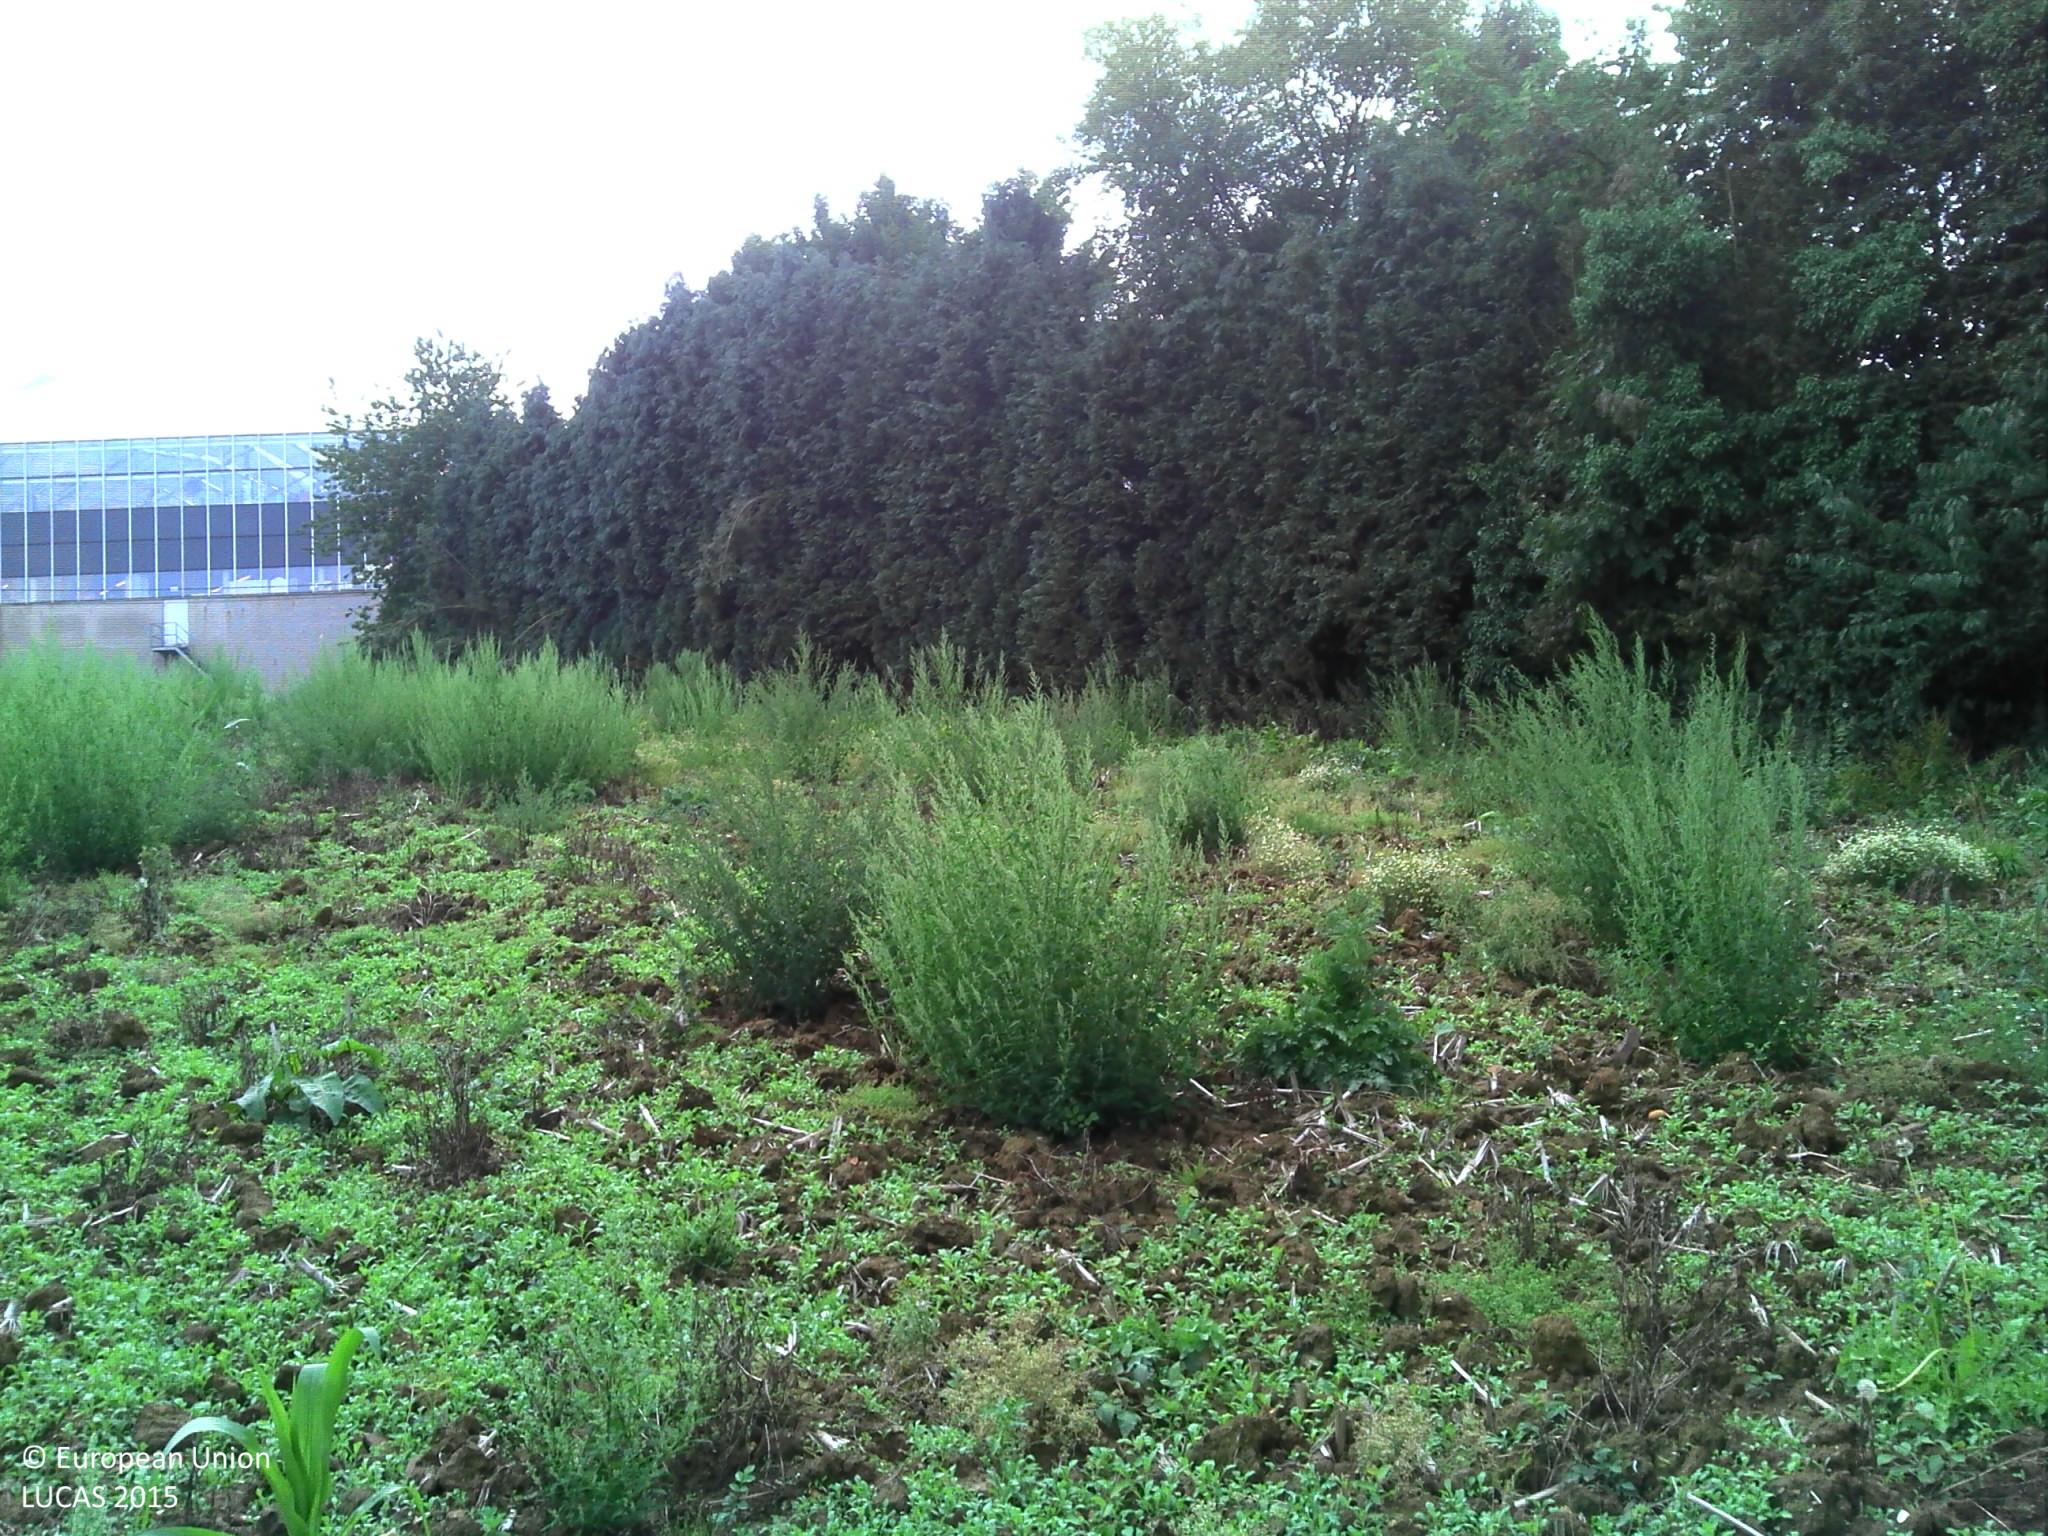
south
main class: Grassland
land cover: Spontaneously vegetated surfaces
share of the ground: > 75 %
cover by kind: herbaceous plants 50 %, unconsolidated bare surface 50 %
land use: Fallow land
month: August
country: BE
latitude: 50.7832
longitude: 2.7408
